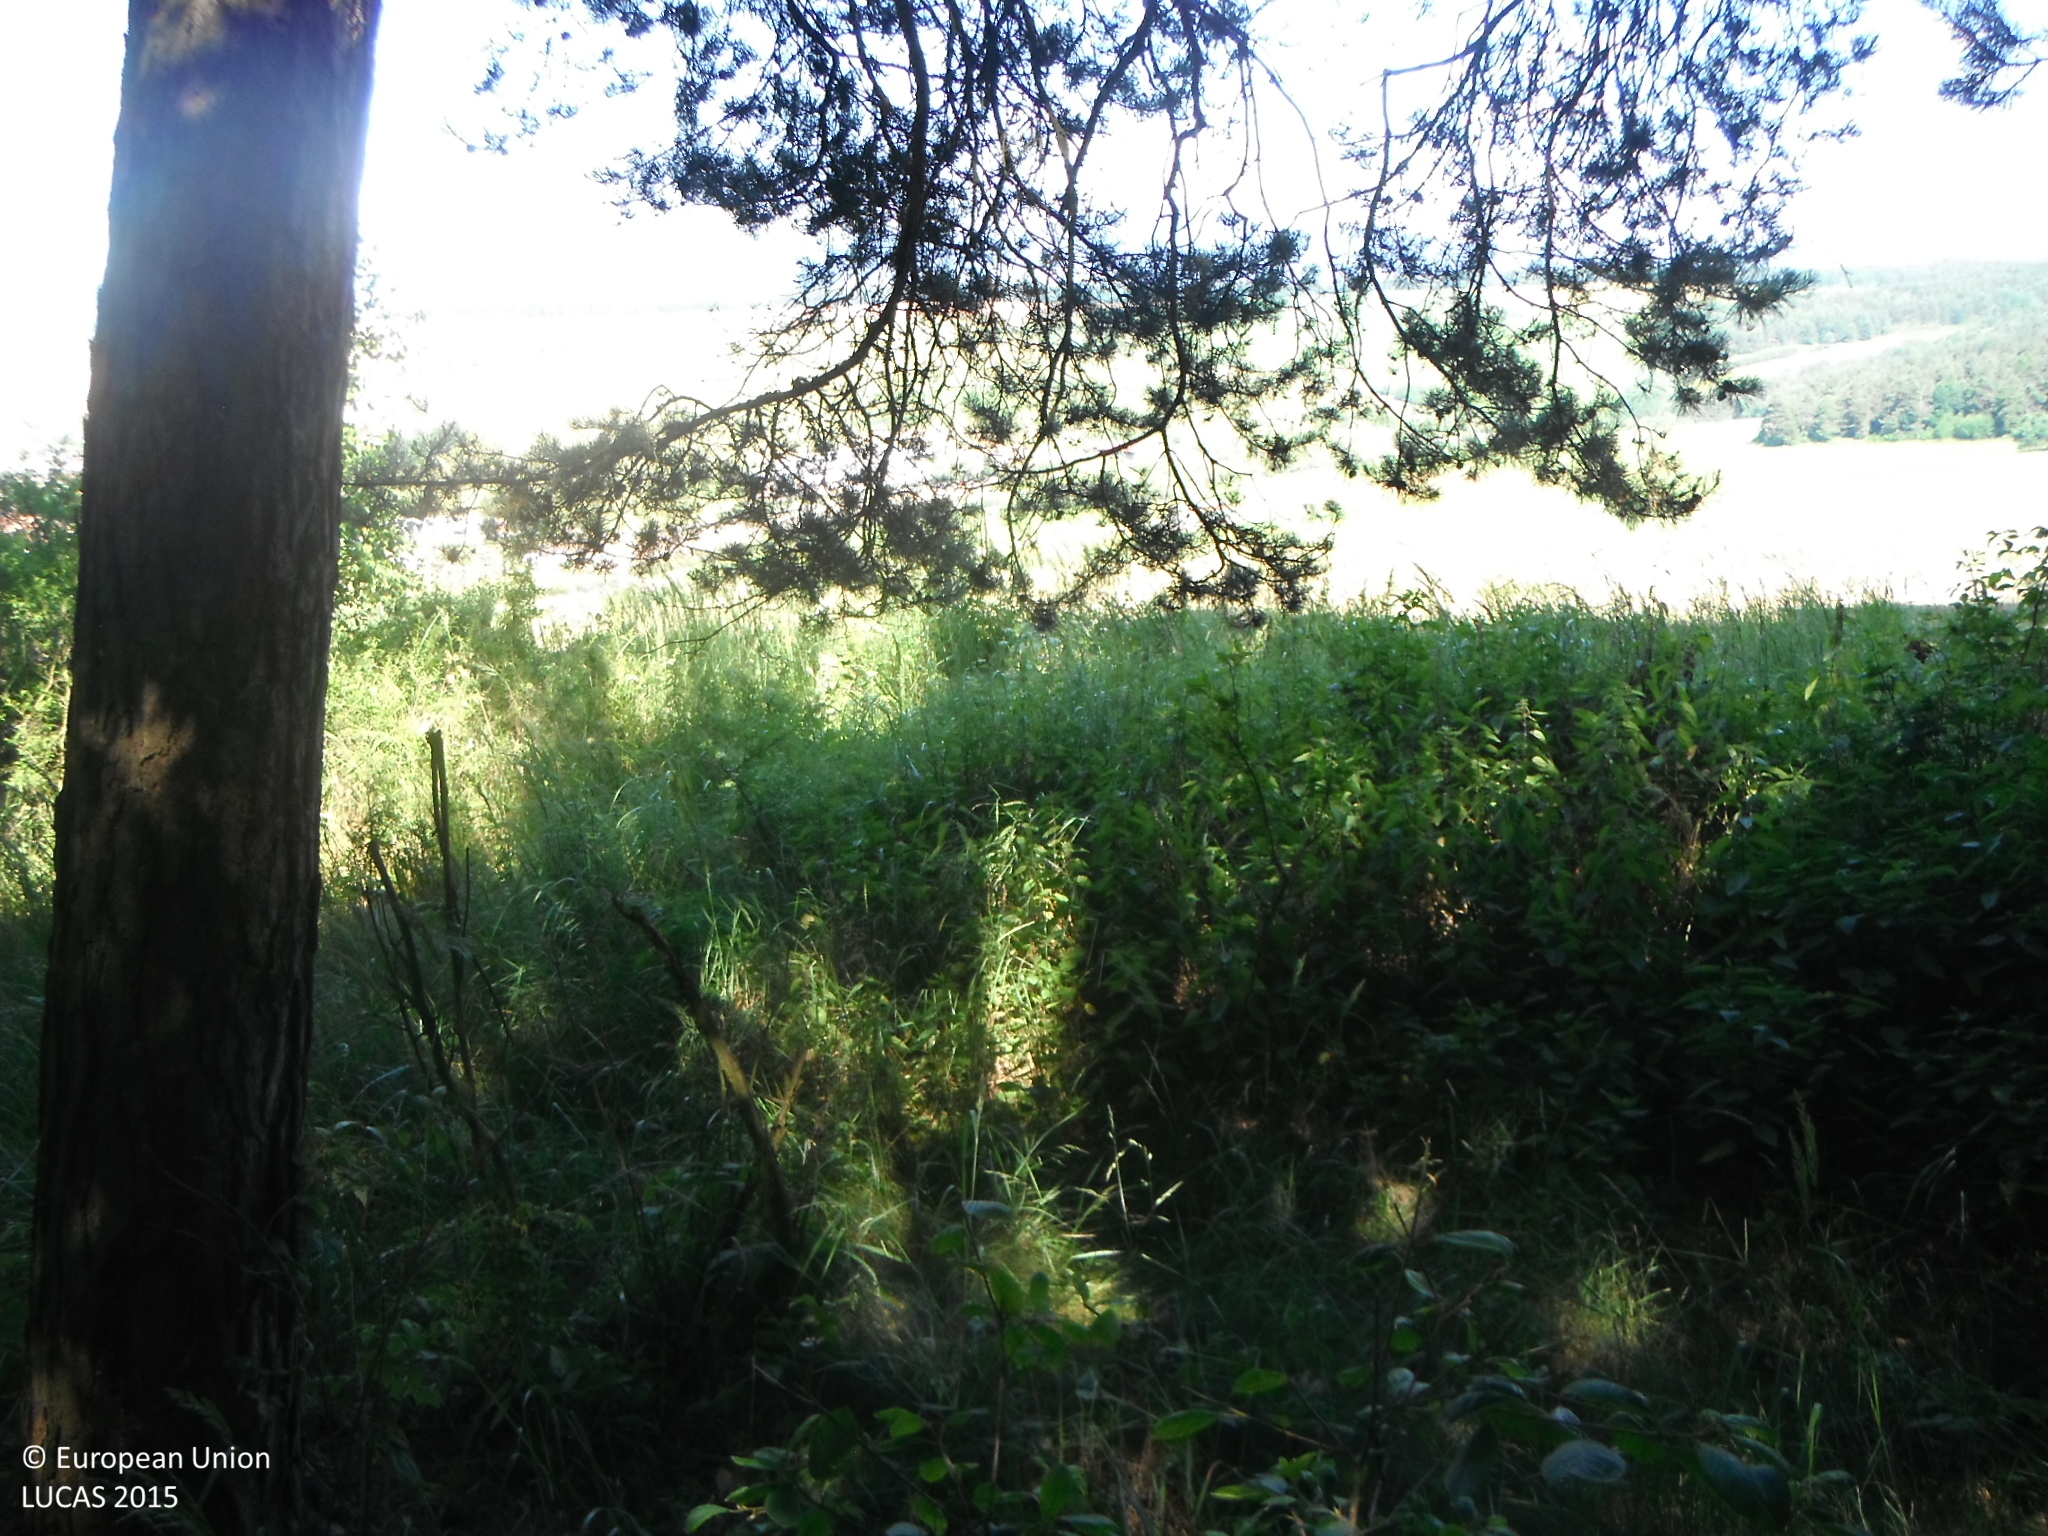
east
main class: Woodland
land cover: Other mixed woodland
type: hemiboreal forest and nemoral coniferous forest and mixed broadleaved-coniferous forest
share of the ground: > 75 %
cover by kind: broadleaved forest trees 55 %, coniferous forest trees 40 %, herbaceous plants 5 %
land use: Forestry
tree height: > 5 m
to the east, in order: Other mixed woodland; Grassland without tree/shrub cover; Electric lines; Grassland without tree/shrub cover
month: July
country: SK
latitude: 48.9353
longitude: 20.6997
